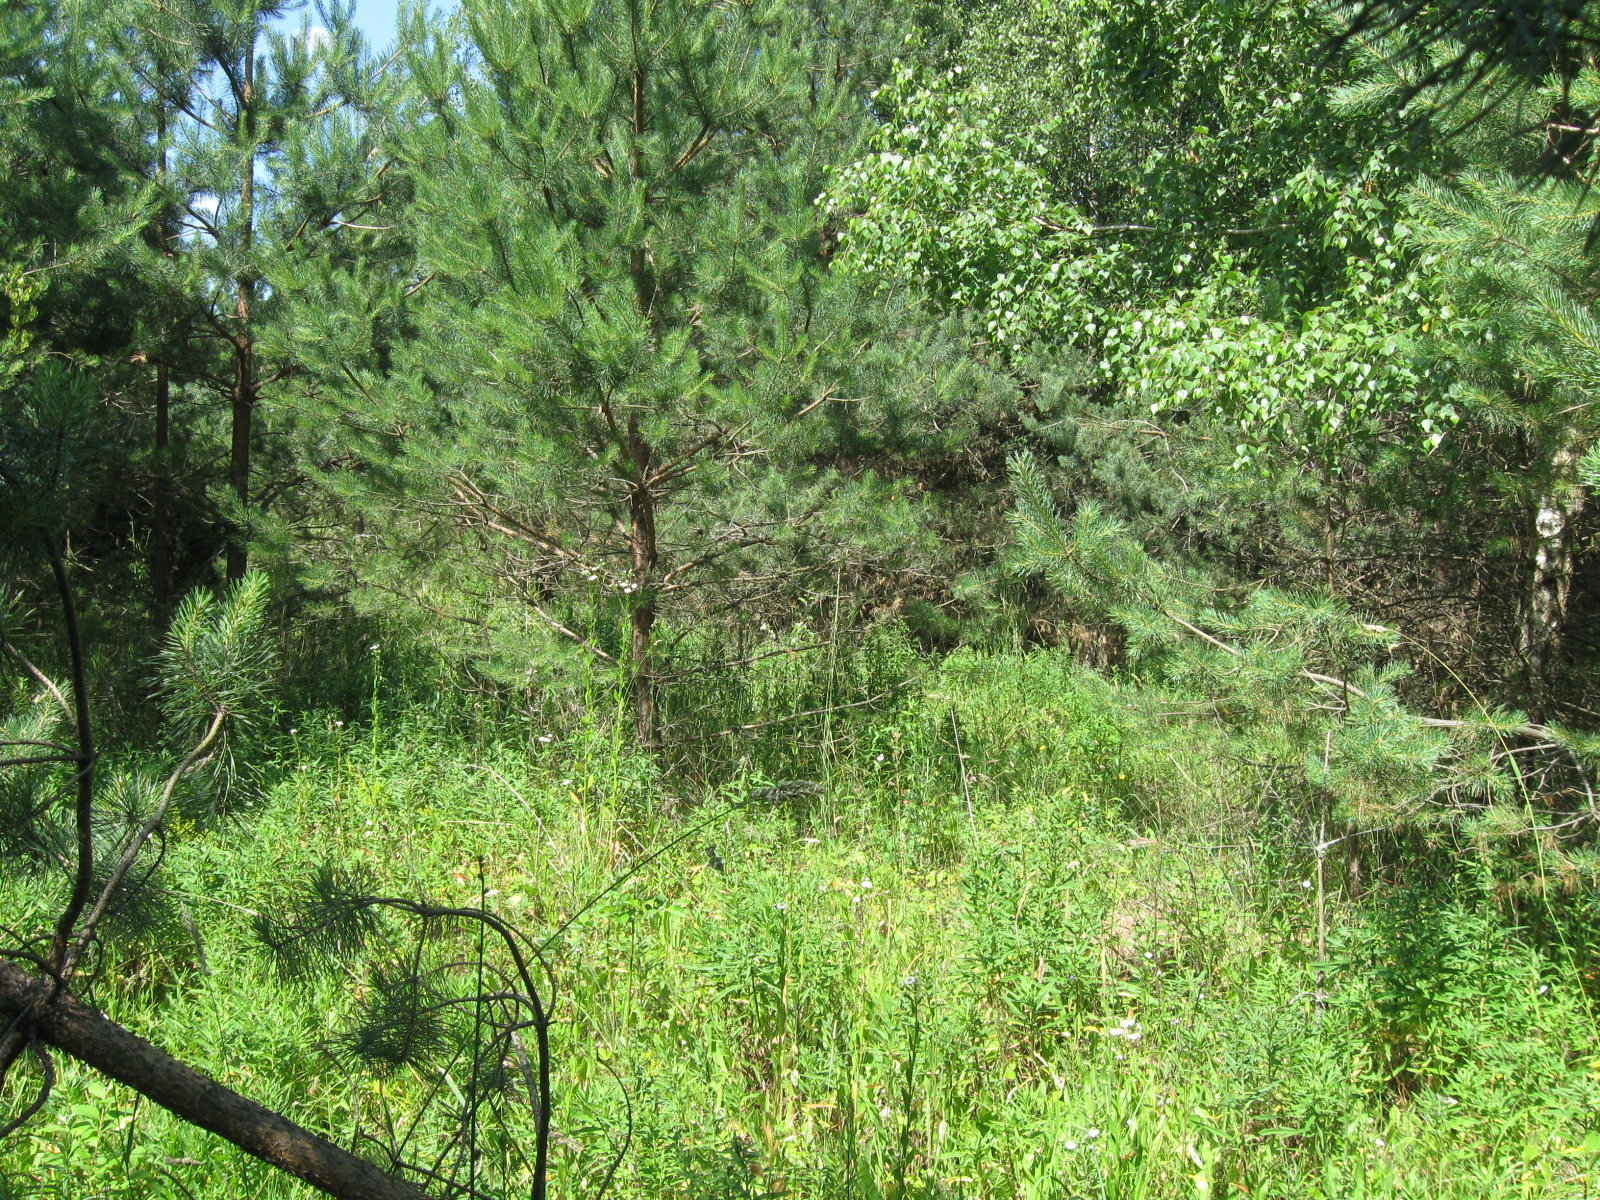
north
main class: Woodland
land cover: Pine dominated mixed woodland
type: hemiboreal forest and nemoral coniferous forest and mixed broadleaved-coniferous forest
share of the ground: > 75 %
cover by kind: coniferous forest trees 50 %, broadleaved forest trees 30 %, herbaceous plants 20 %
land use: Forestry
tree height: > 5 m
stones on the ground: < 10 %
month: July
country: LT
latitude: 54.2126
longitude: 24.2827
